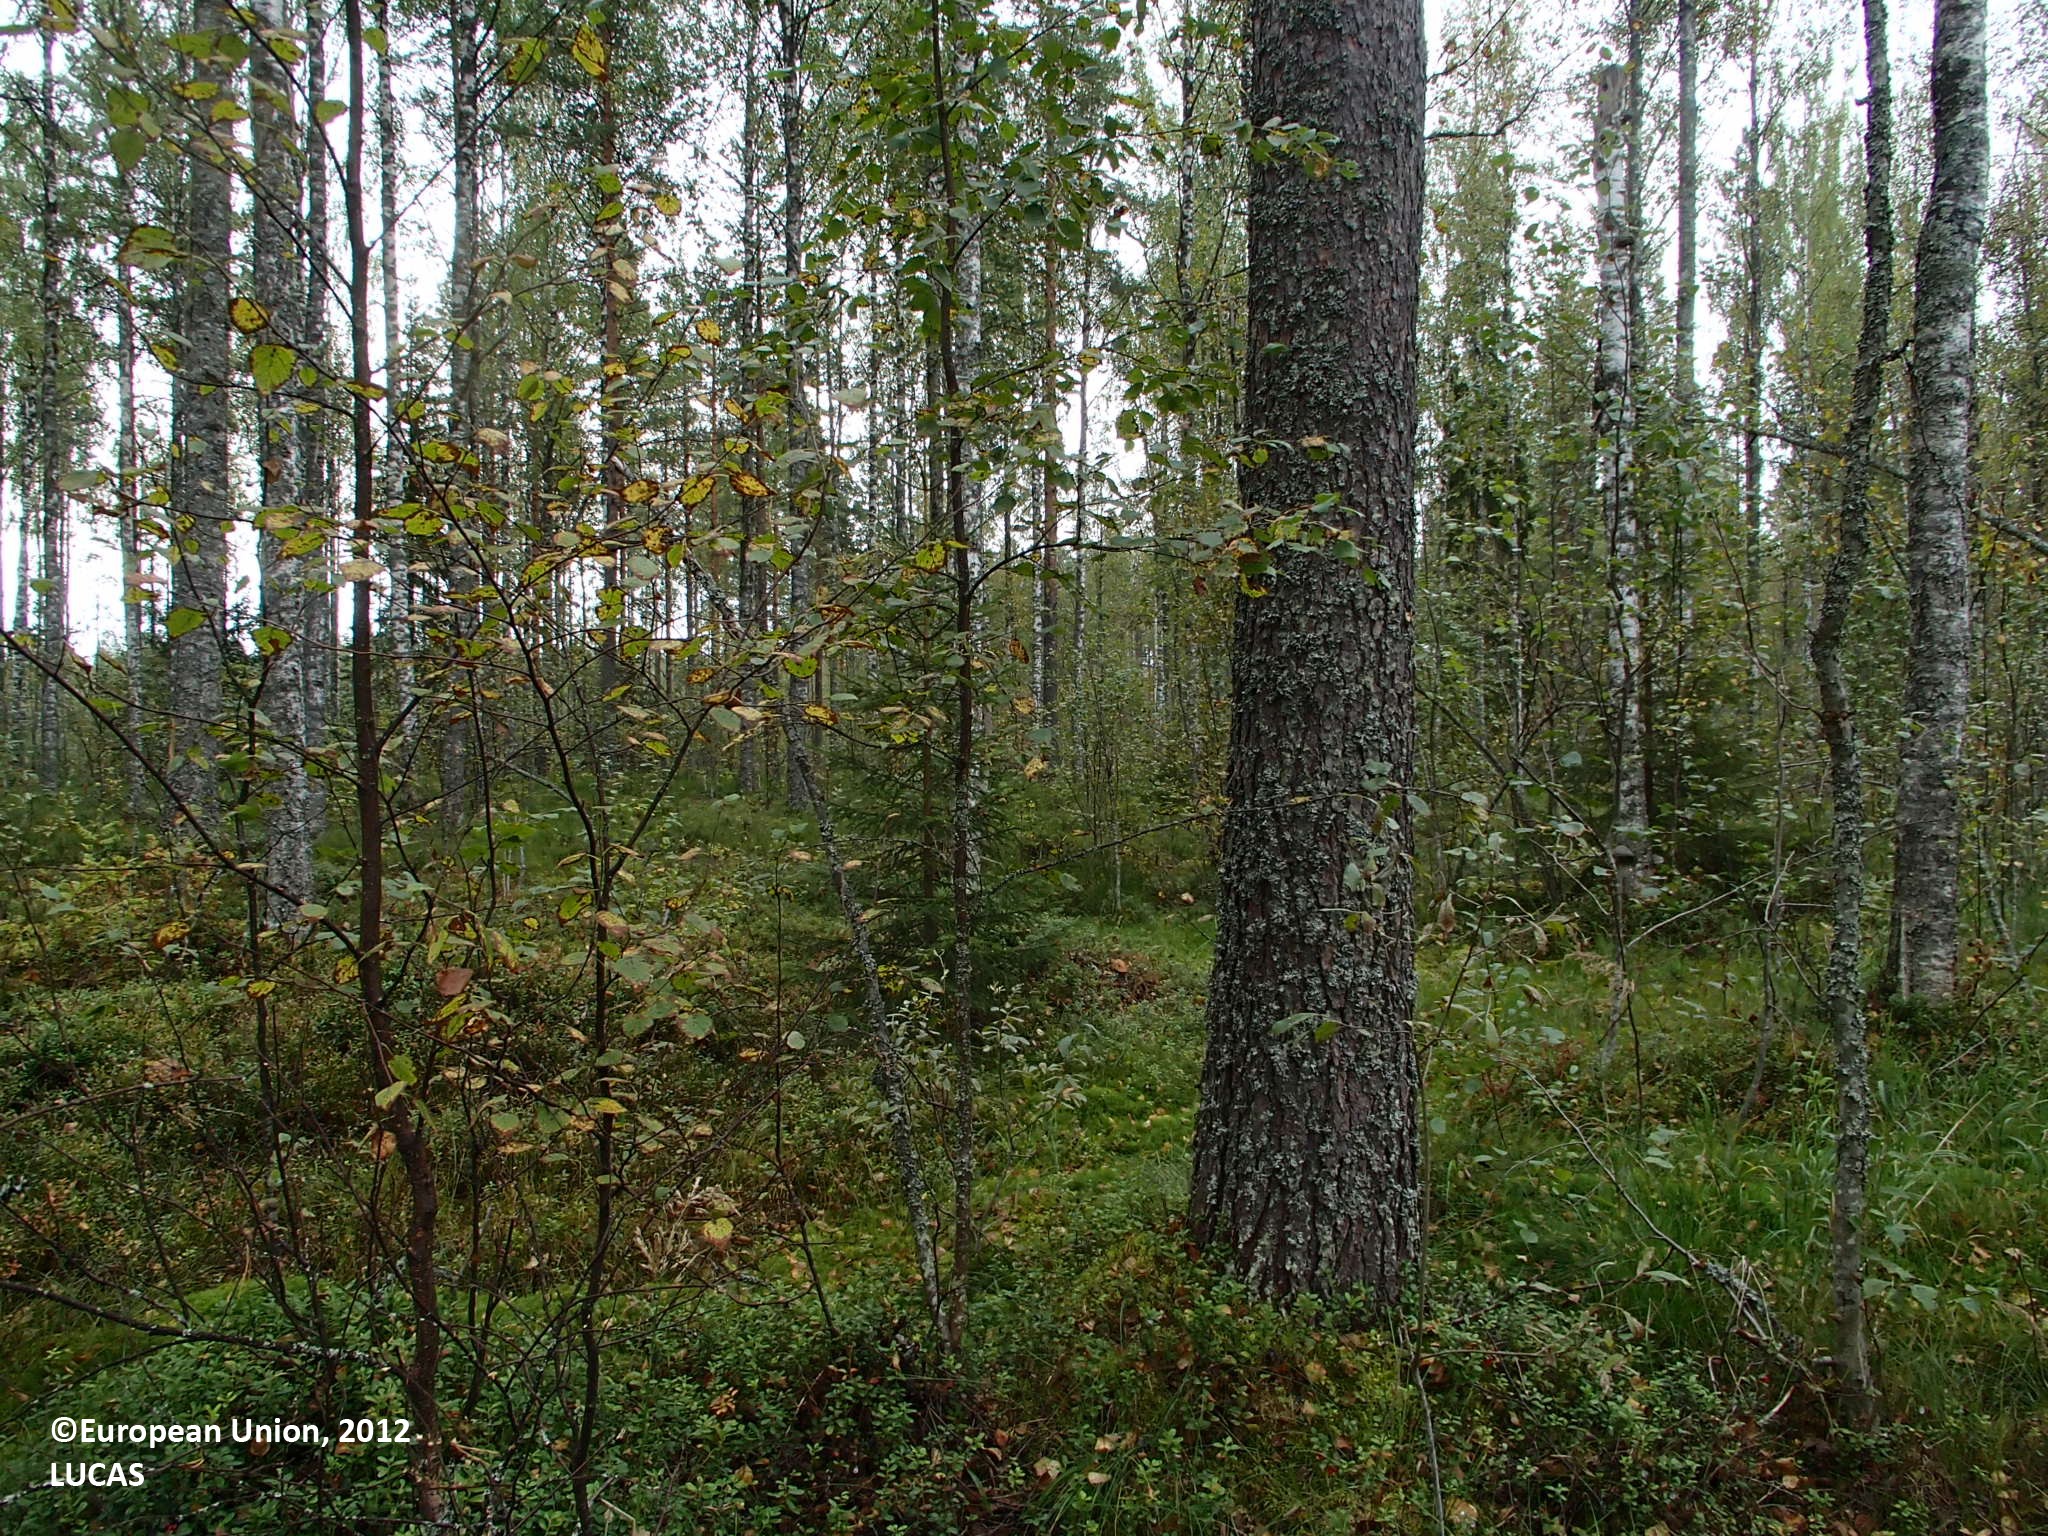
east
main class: Woodland
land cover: Pine dominated mixed woodland
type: boreal forest
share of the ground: 50 - 75 %
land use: Forestry
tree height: > 5 m
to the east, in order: Pine dominated mixed woodland; Broadleaved woodland; Spontaneously vegetated surfaces; Spruce dominated coniferous woodland
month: September
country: FI
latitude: 63.8481
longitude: 26.0749
